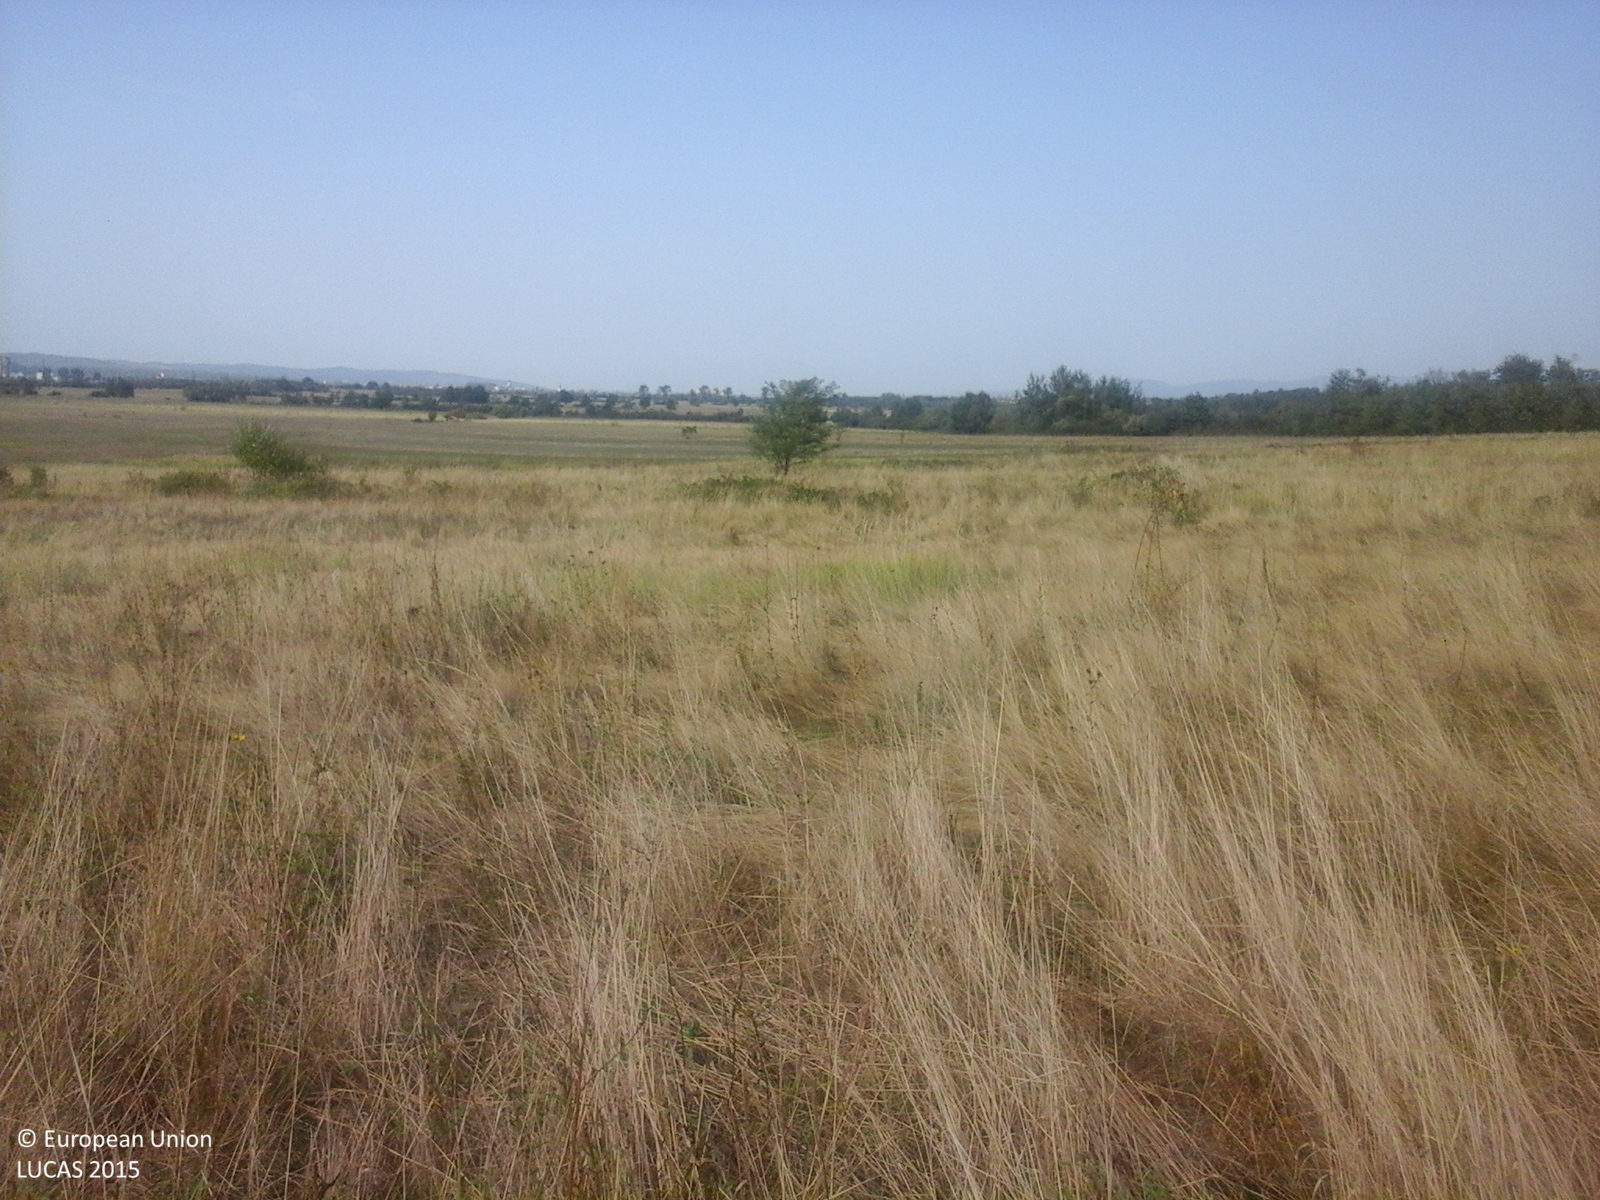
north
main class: Grassland
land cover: Grassland without tree/shrub cover
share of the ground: > 75 %
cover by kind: herbaceous plants 100 %
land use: Agriculture (excluding fallow land and kitchen gardens)
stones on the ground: < 10 %
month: September
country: RO
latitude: 45.3697
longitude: 22.2603
